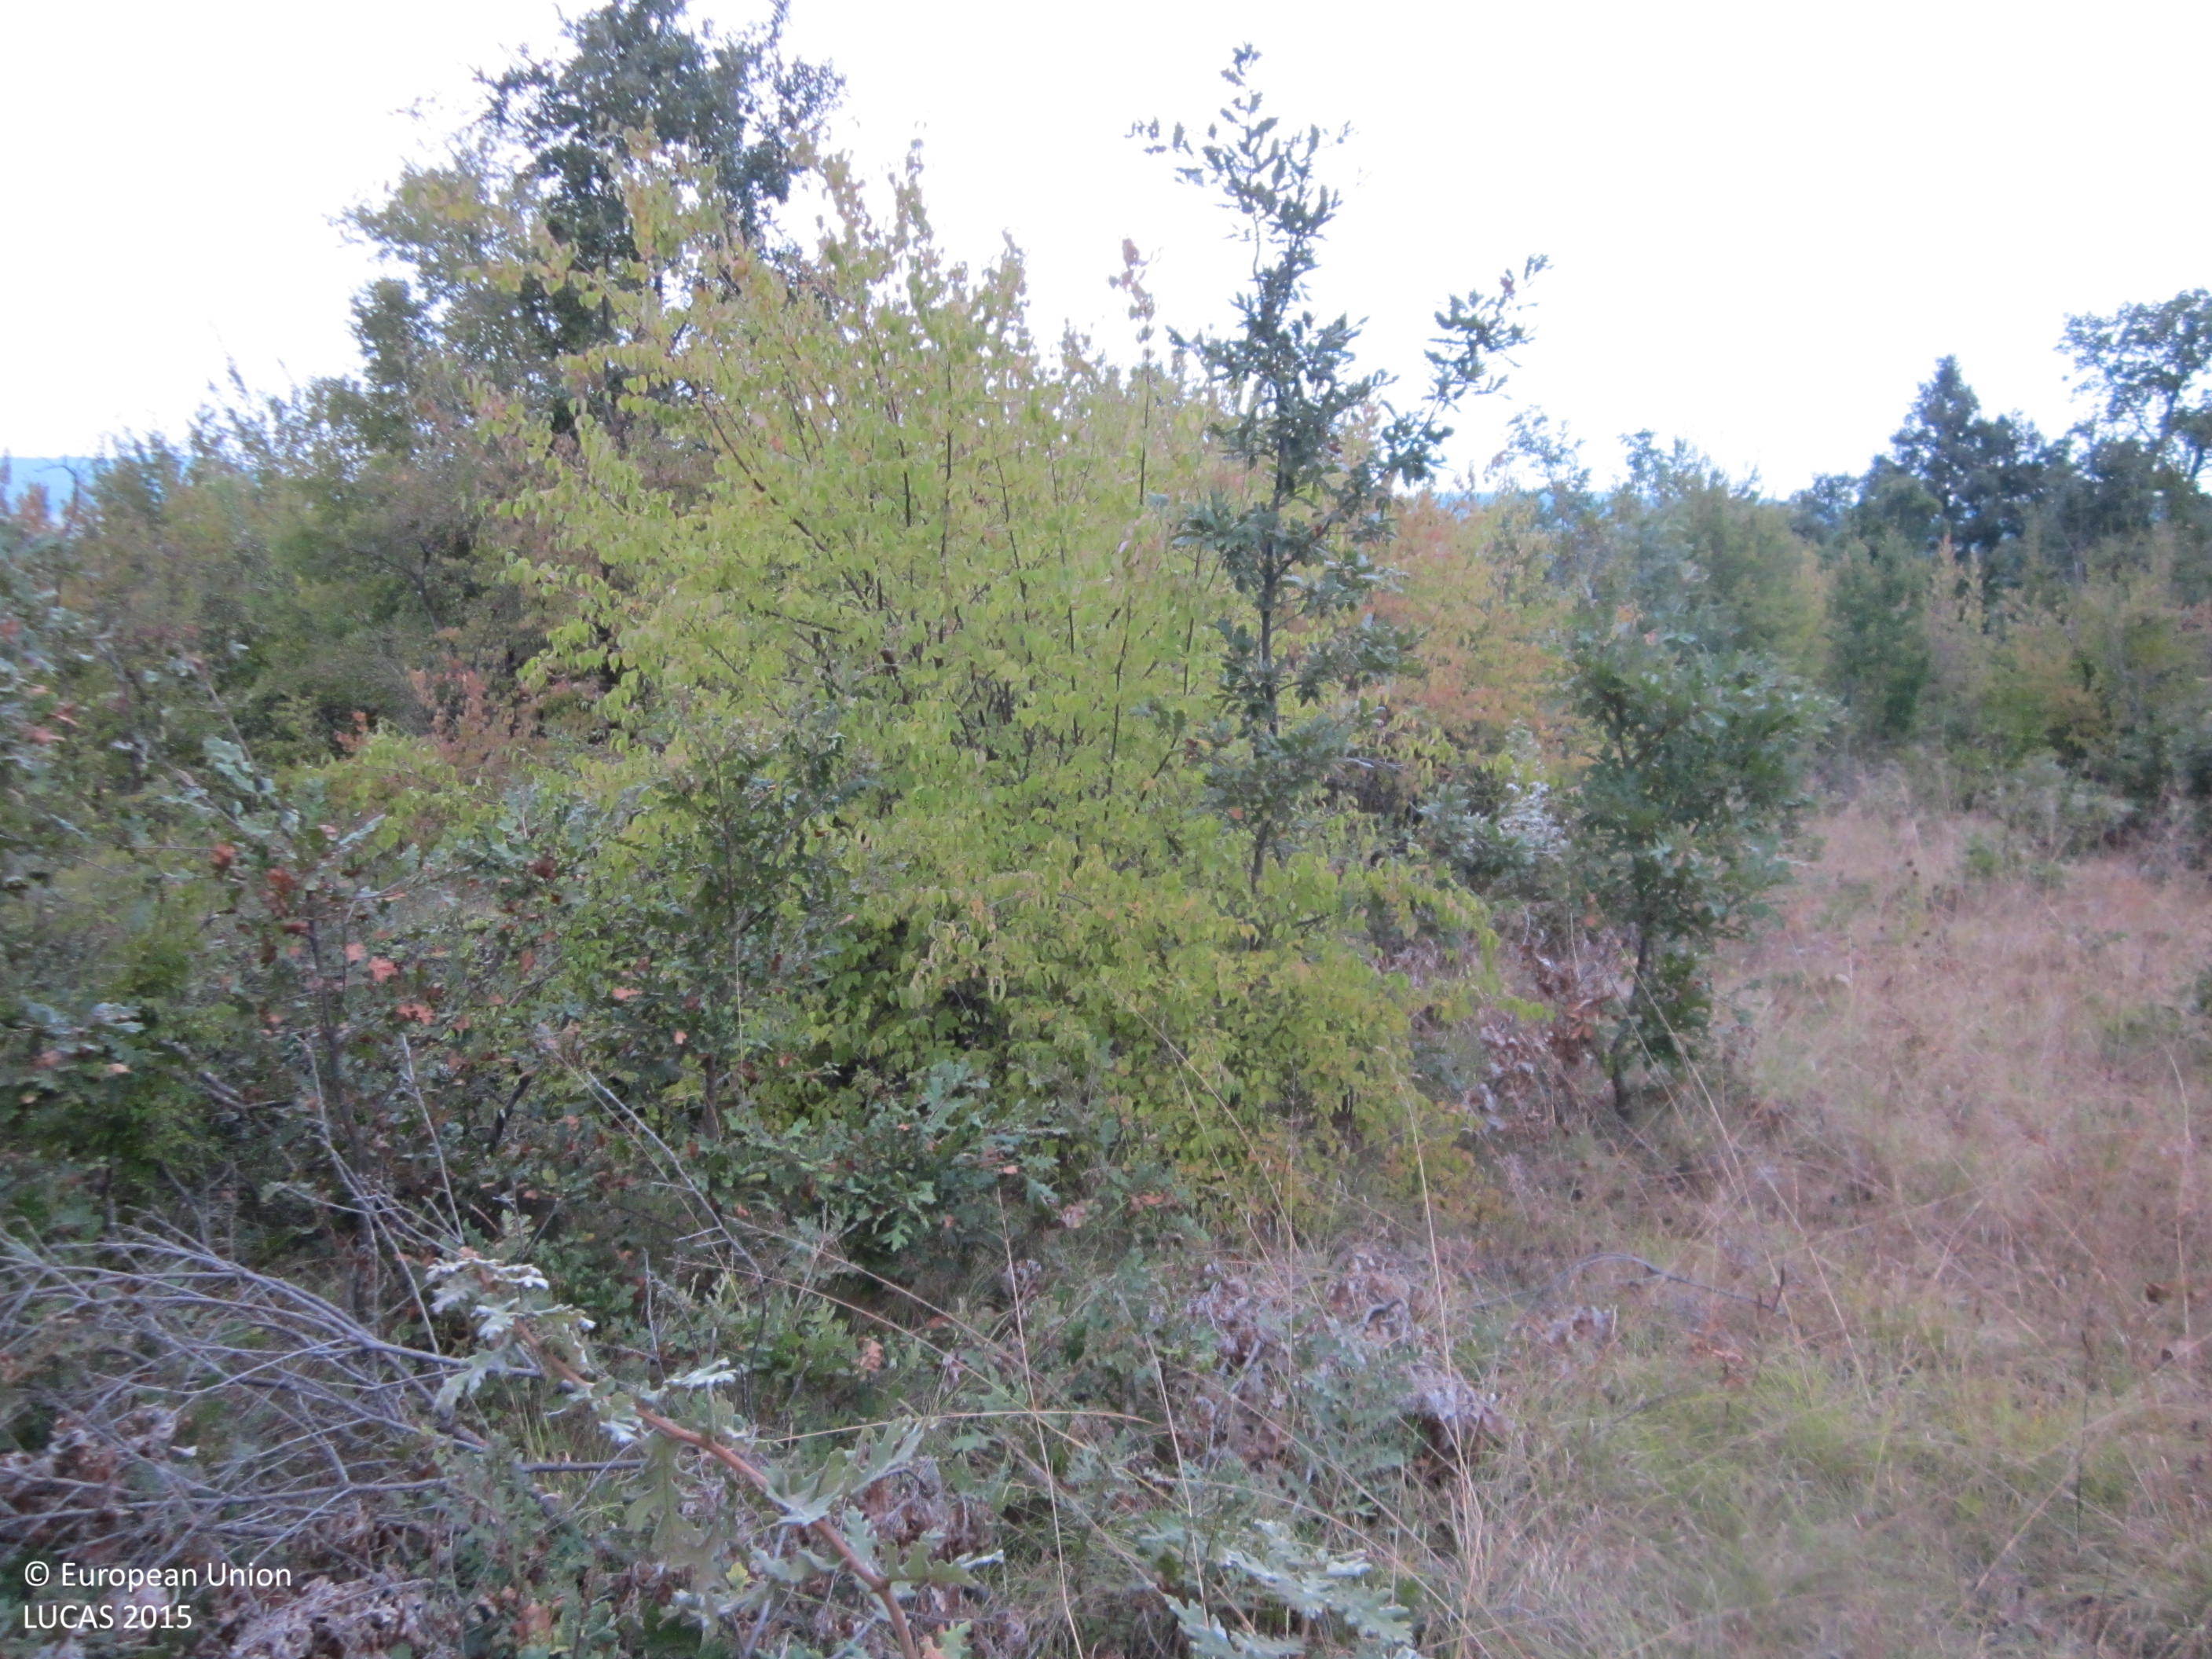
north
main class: Woodland
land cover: Broadleaved woodland
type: thermophilous deciduous forest
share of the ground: 50 - 75 %
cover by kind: broadleaved forest trees 60 %, herbaceous plants 30 %, shrubs 10 %
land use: Forestry
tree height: > 5 m
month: September
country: BG
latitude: 42.7805
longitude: 27.3651
